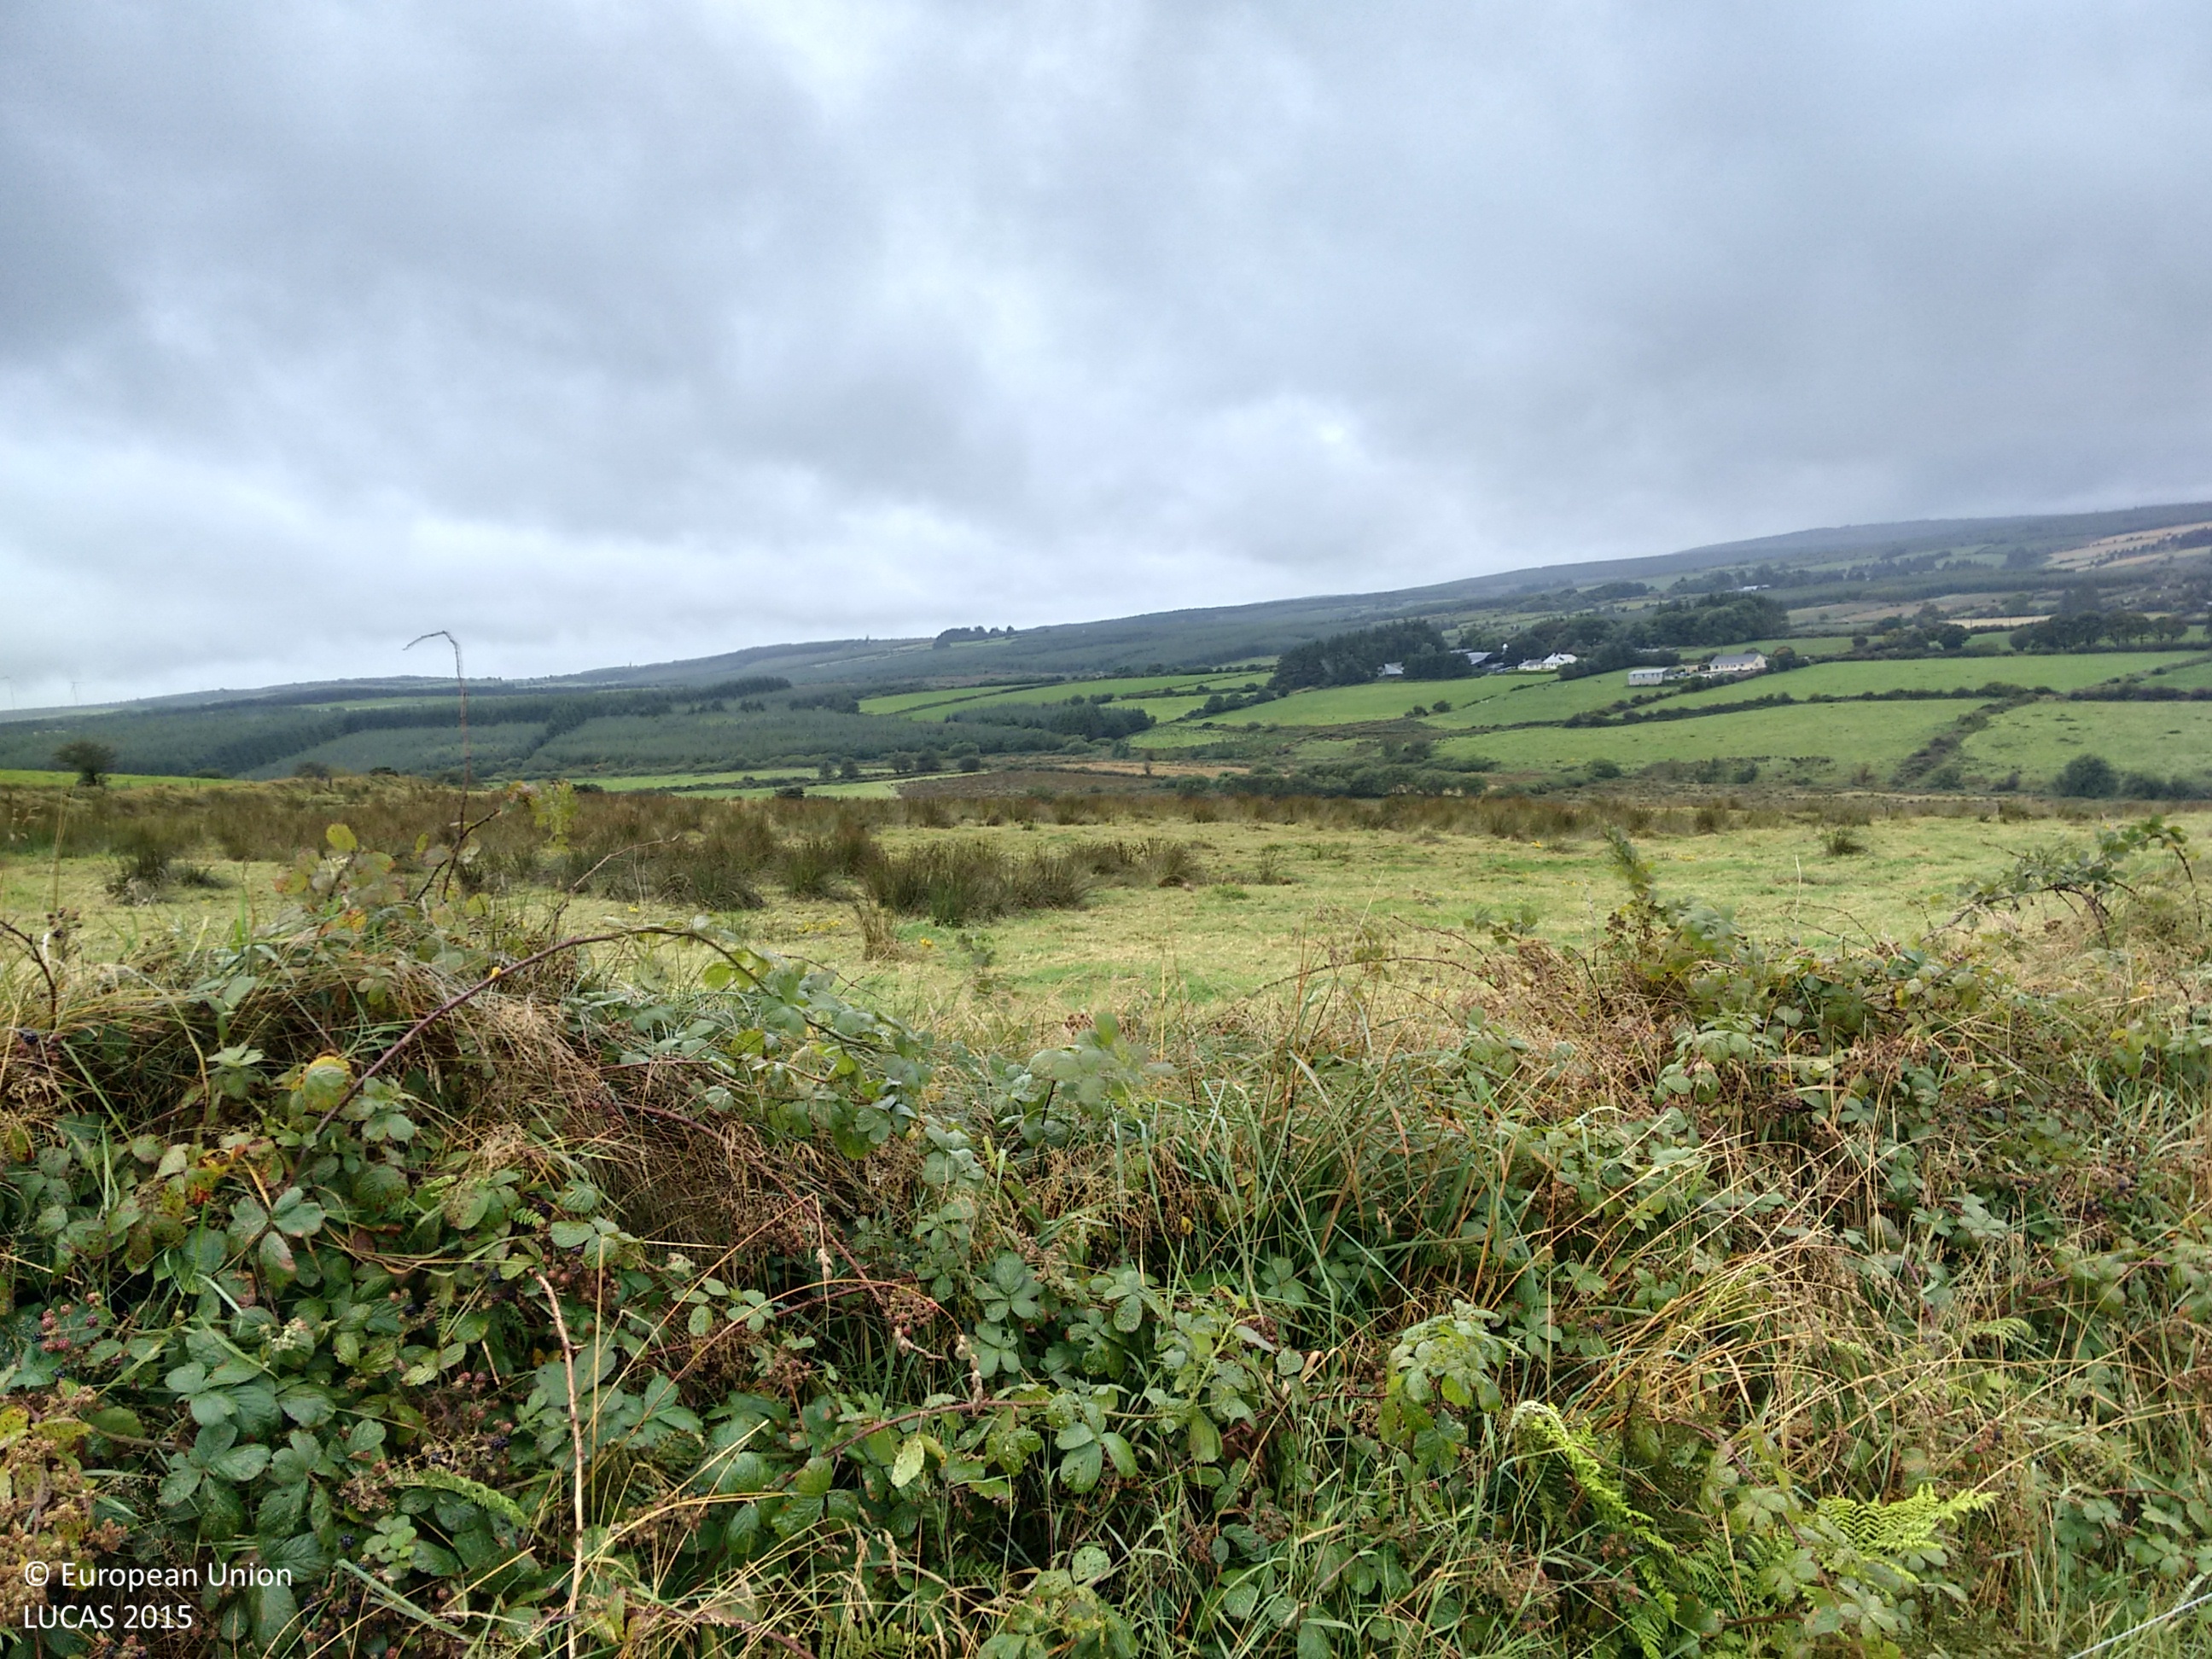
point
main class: Grassland
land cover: Grassland without tree/shrub cover
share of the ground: > 75 %
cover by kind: herbaceous plants 100 %
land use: Agriculture (excluding fallow land and kitchen gardens)
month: September
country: IE
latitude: 52.2801
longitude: -9.0196
